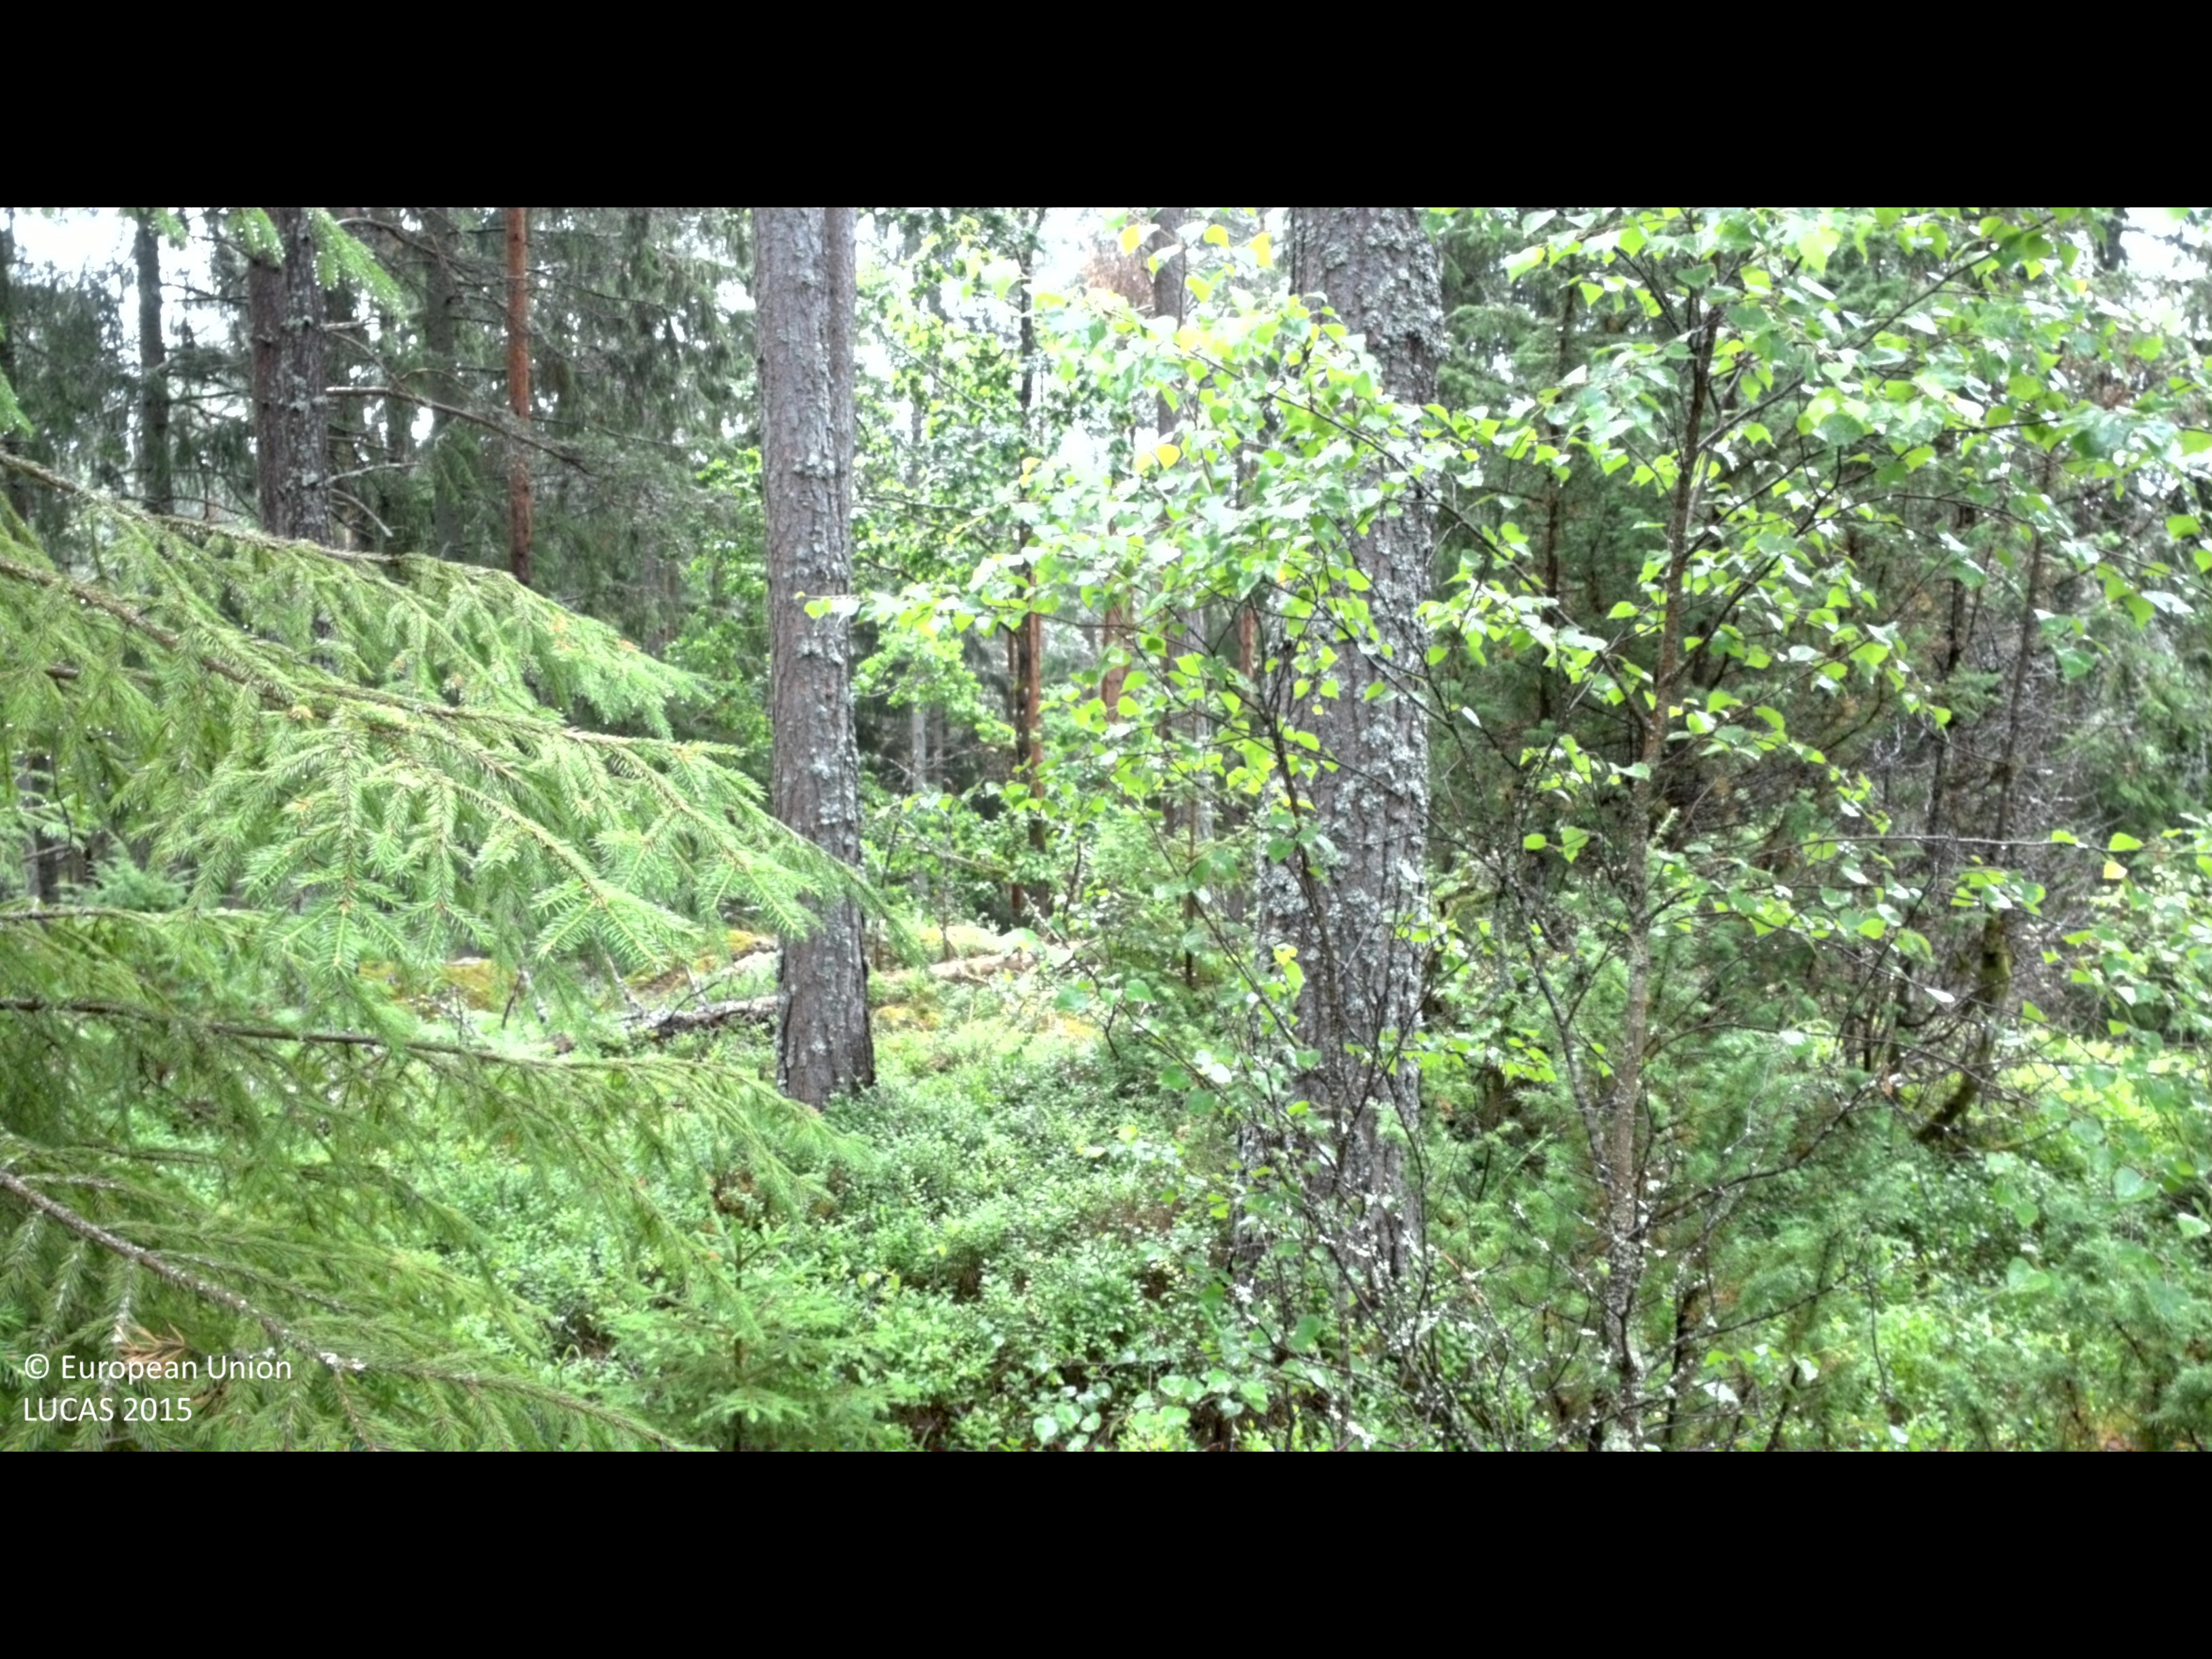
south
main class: Woodland
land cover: Pine dominated coniferous woodland
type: boreal forest
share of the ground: 50 - 75 %
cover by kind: coniferous forest trees 55 %, shrubs 30 %, lichens and mosses 10 %, herbaceous plants 5 %
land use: Forestry
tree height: > 5 m
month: July
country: SE
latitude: 58.3652
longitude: 16.2008
